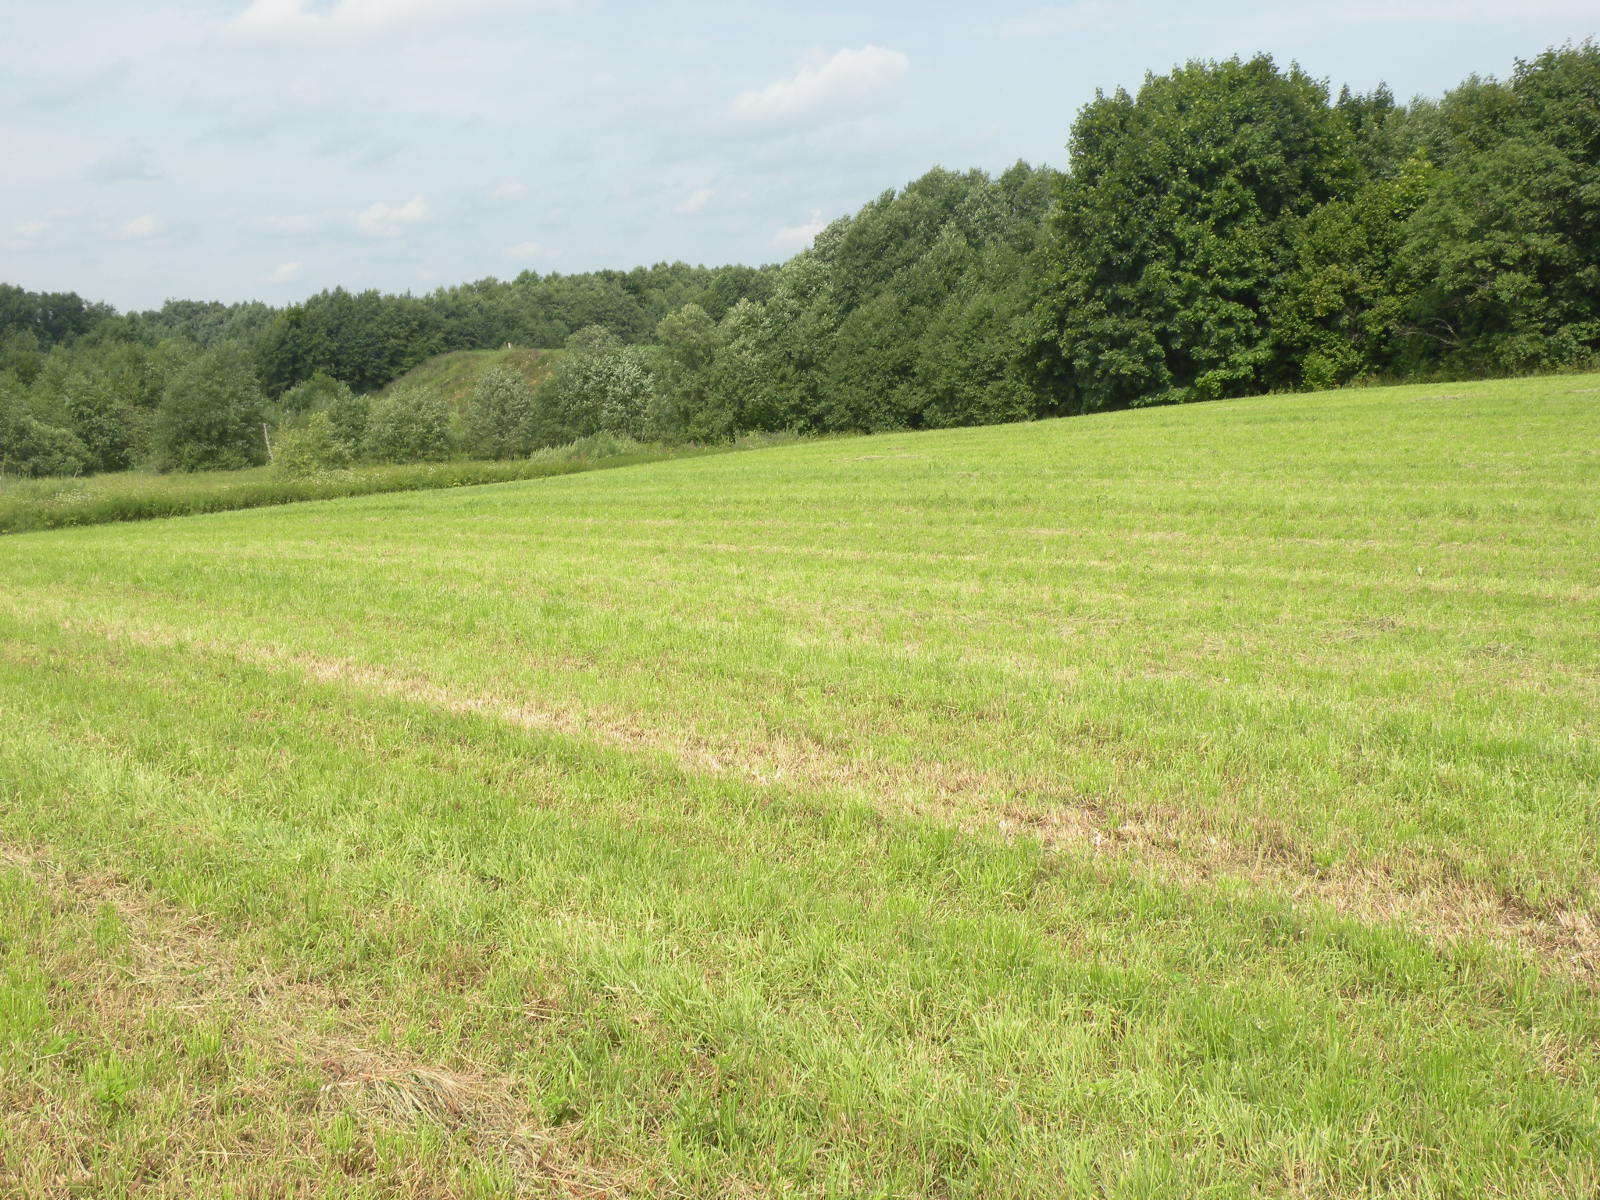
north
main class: Grassland
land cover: Grassland without tree/shrub cover
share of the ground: > 75 %
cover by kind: herbaceous plants 100 %
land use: Agriculture (excluding fallow land and kitchen gardens)
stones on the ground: < 10 %
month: July
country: LV
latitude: 55.8211
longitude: 26.6758
